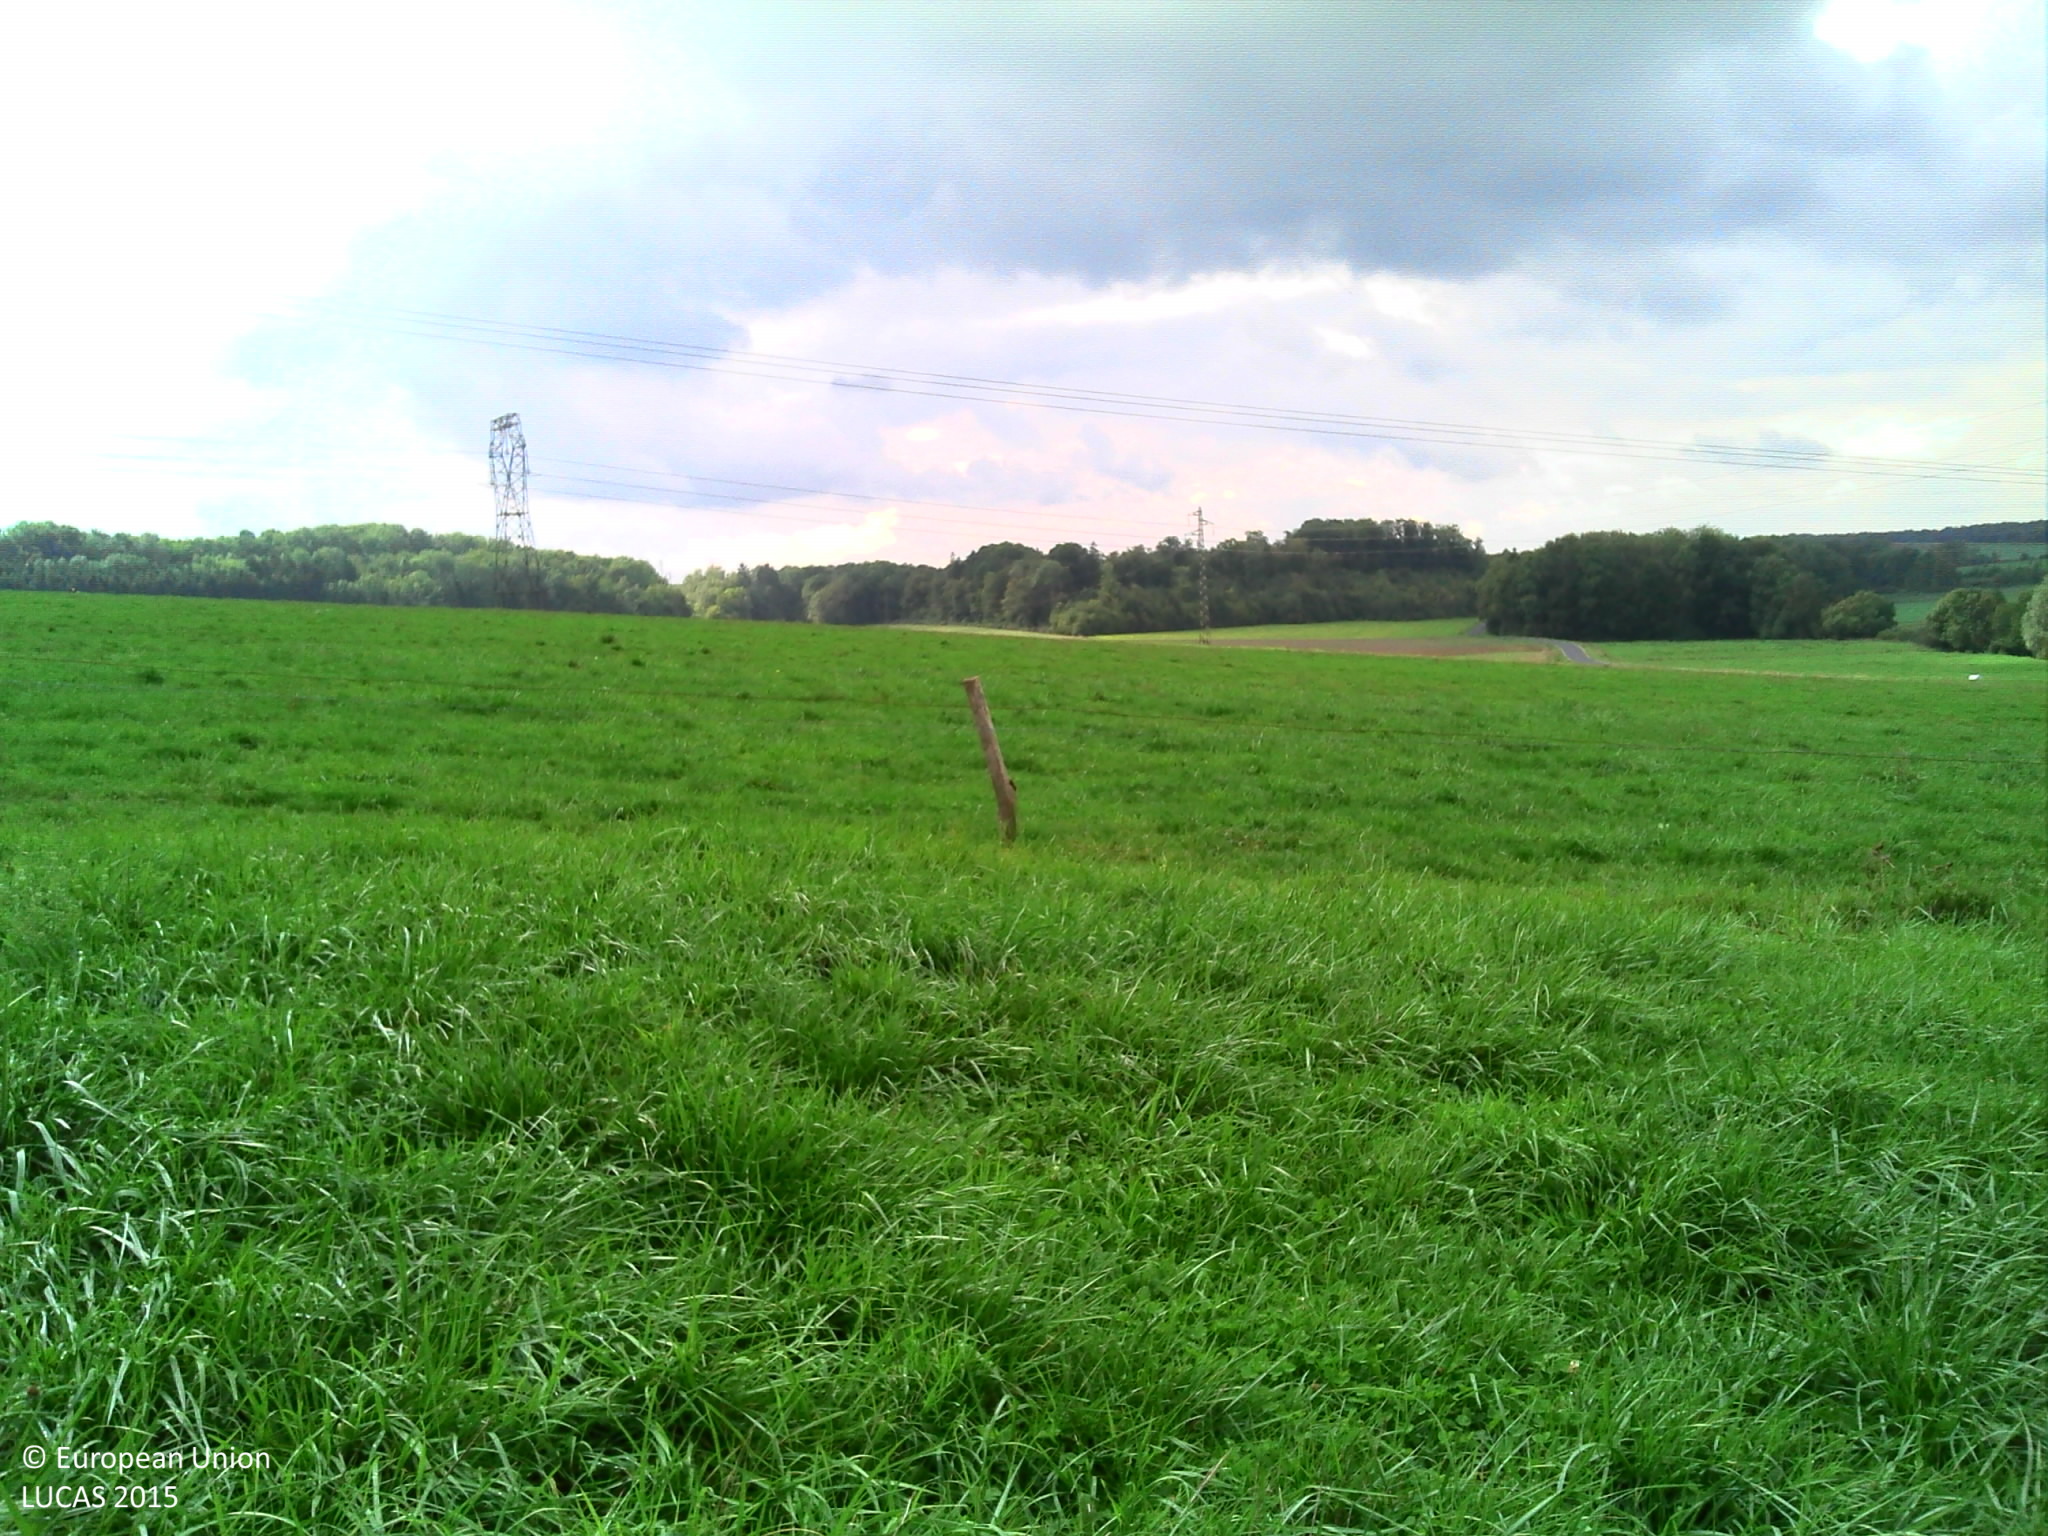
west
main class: Grassland
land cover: Grassland without tree/shrub cover
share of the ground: > 75 %
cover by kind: herbaceous plants 95 %, consolidated bare surface 5 %
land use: Agriculture (excluding fallow land and kitchen gardens)
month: September
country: FR
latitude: 48.5745
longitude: 6.8426
